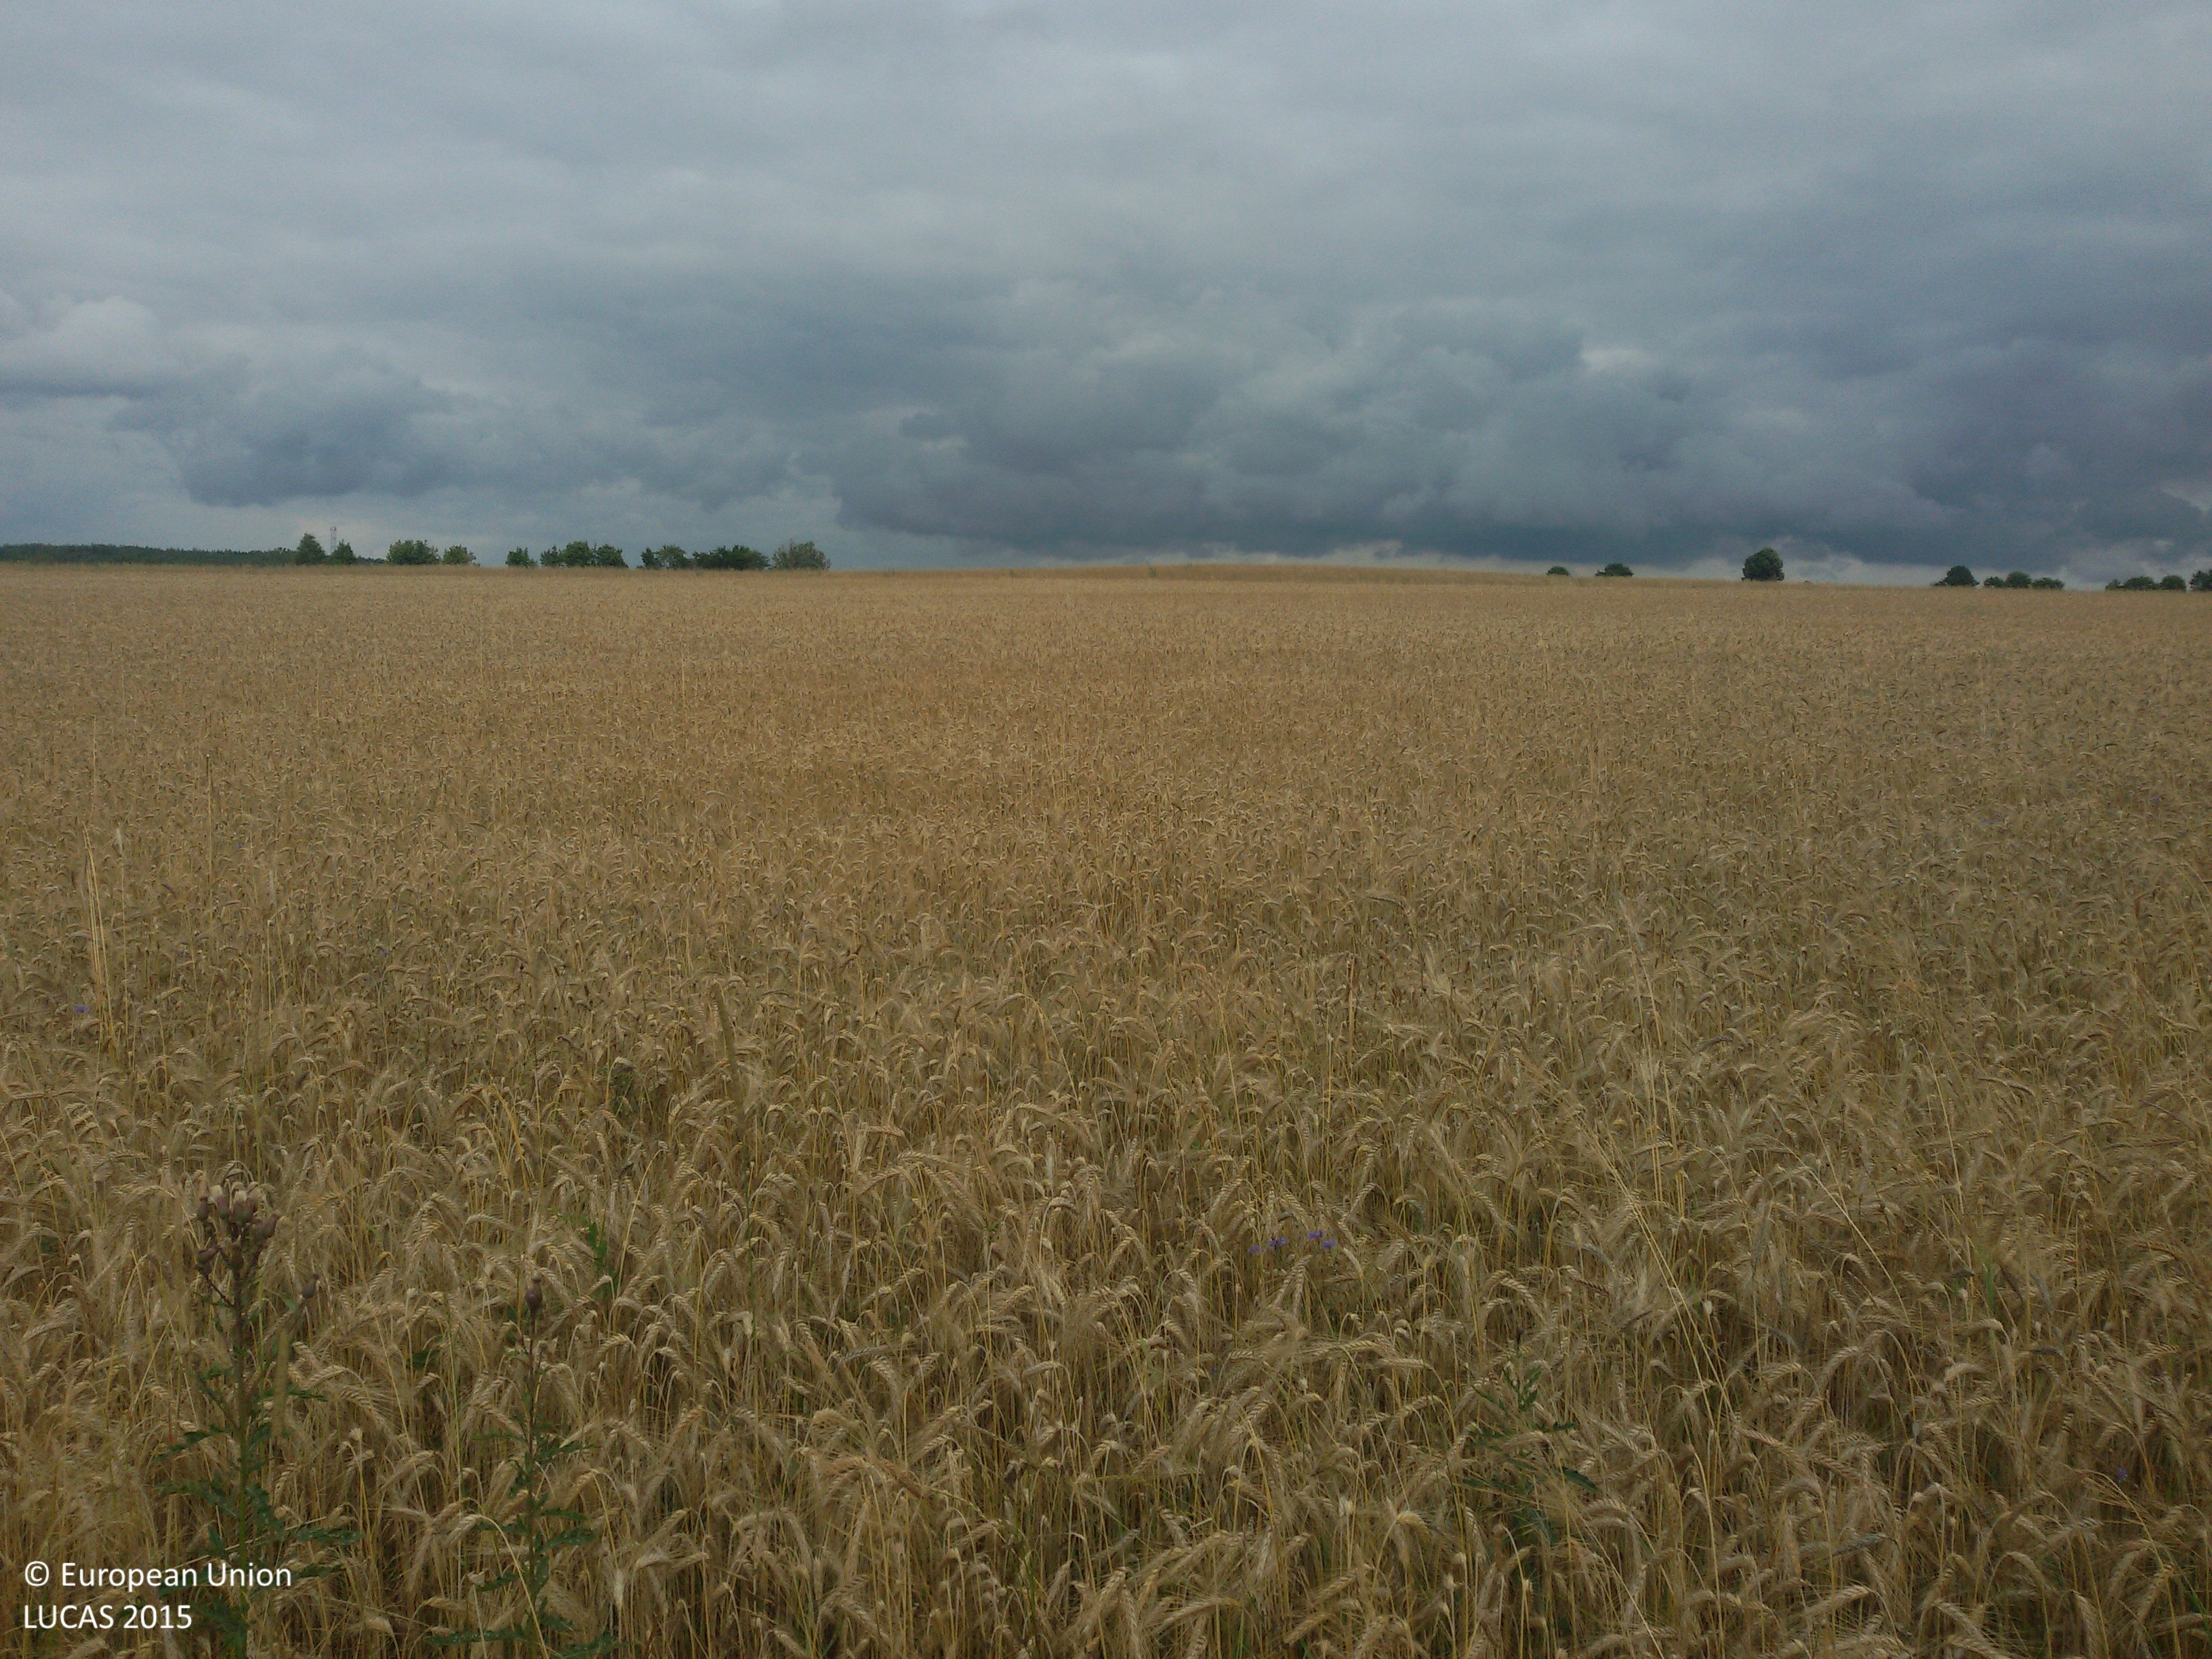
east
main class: Cropland
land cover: Triticale
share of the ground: > 75 %
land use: Agriculture (excluding fallow land and kitchen gardens)
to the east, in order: Triticale; Dry pulses
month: July
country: PL
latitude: 53.6379
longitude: 23.5607
